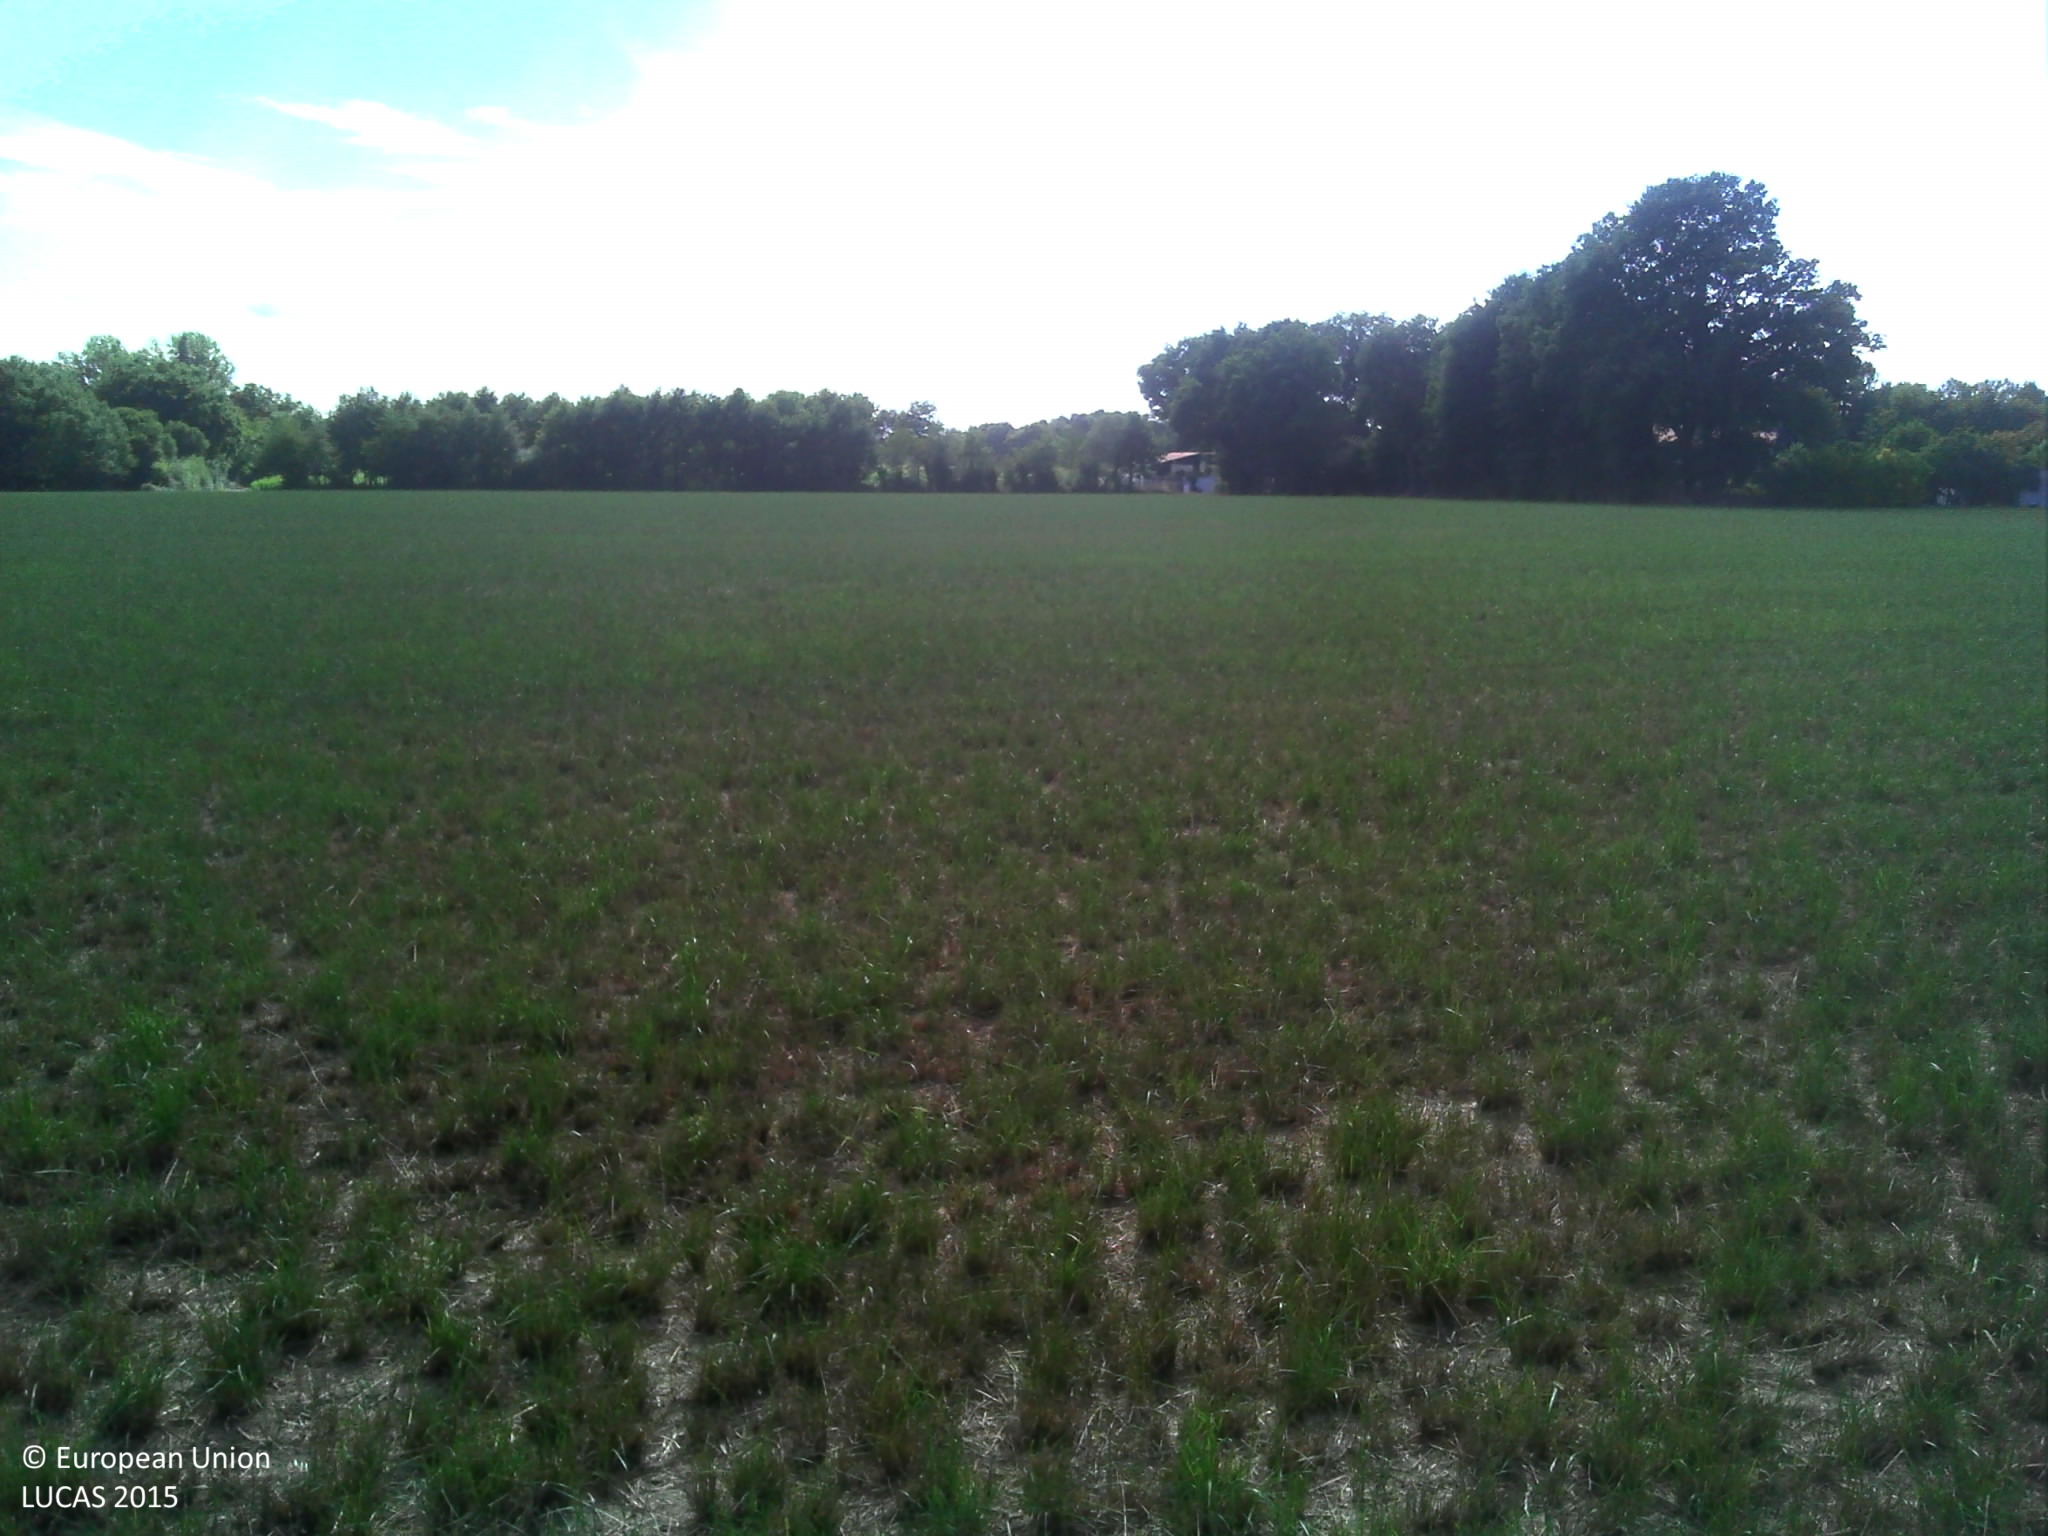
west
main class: Cropland
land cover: Temporary grasslands
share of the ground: > 75 %
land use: Agriculture (excluding fallow land and kitchen gardens)
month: August
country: FR
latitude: 46.7288
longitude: -1.3294
